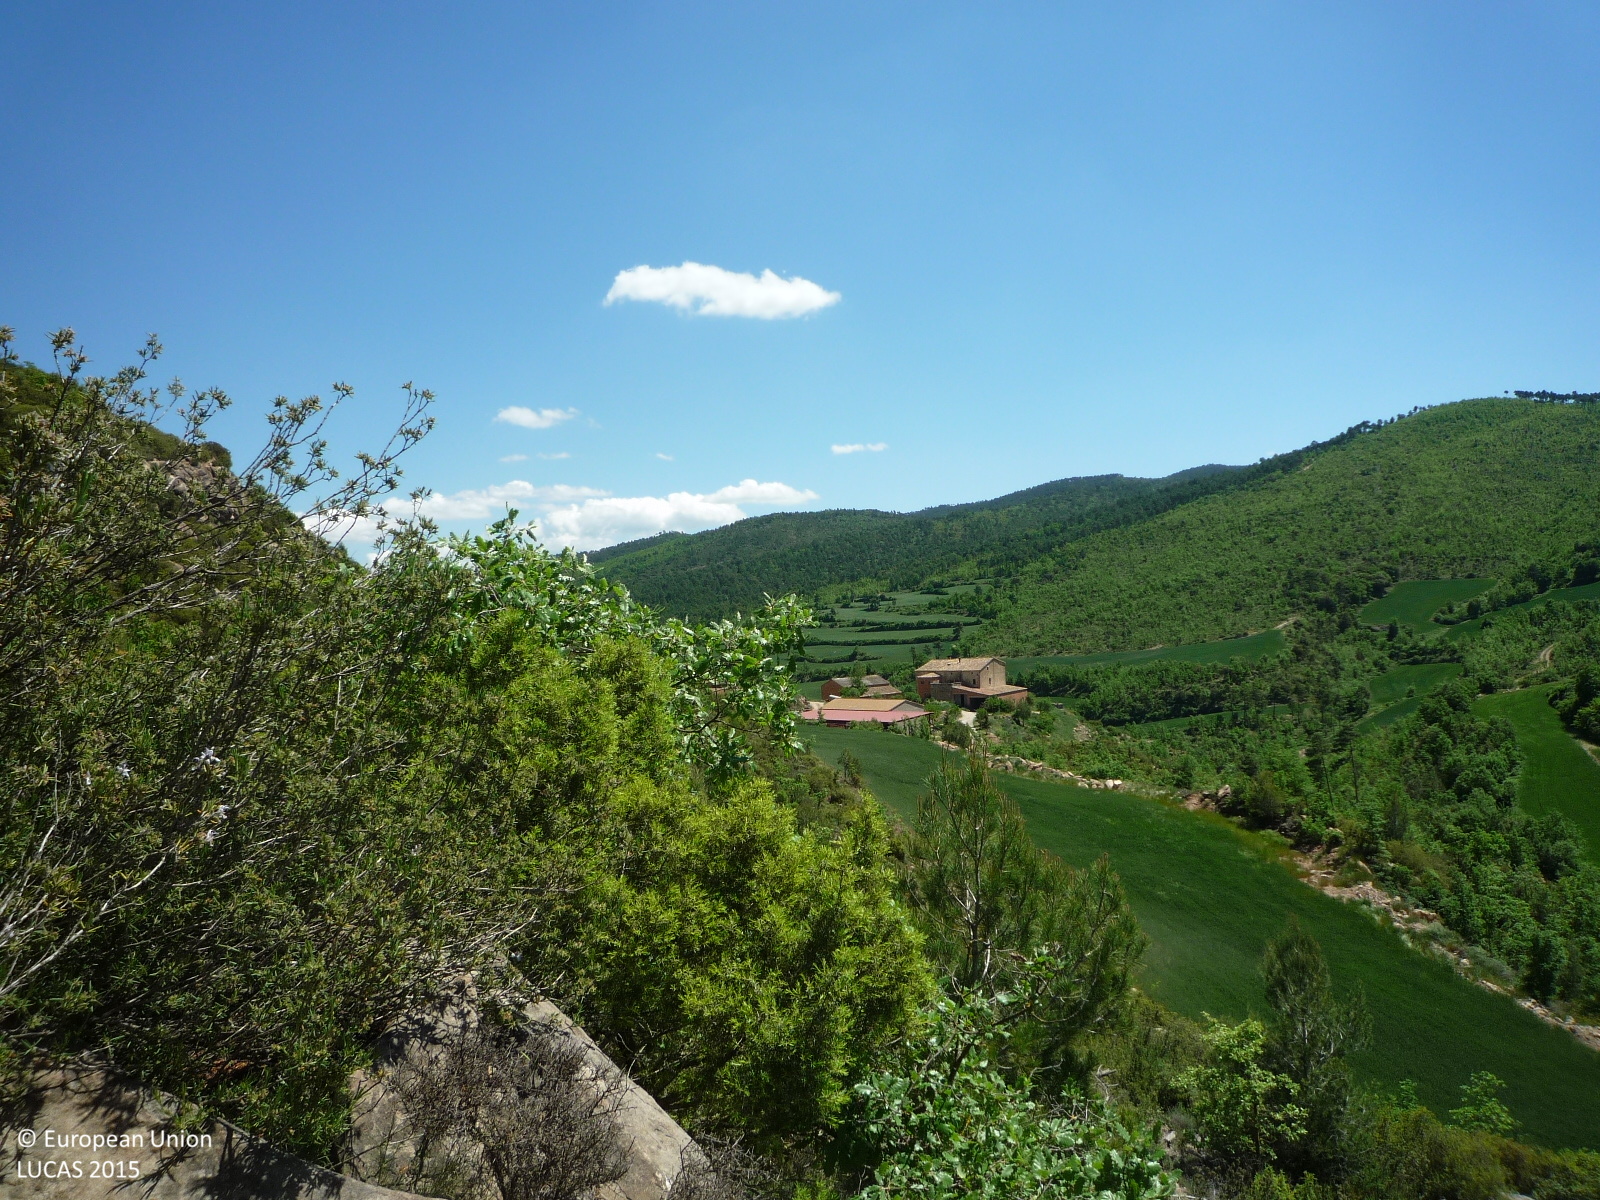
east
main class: Shrubland
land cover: Shrubland with sparse tree cover
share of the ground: > 75 %
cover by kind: shrubs 95 %, coniferous forest trees 5 %
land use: Semi-natural and natural areas not in use
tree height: < 5 m
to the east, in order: Shrubland with sparse tree cover; Tracks; Shrubland with sparse tree cover; Rock outcrops; Shrubland with sparse tree cover
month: May
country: ES
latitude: 41.8165
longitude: 1.6234
